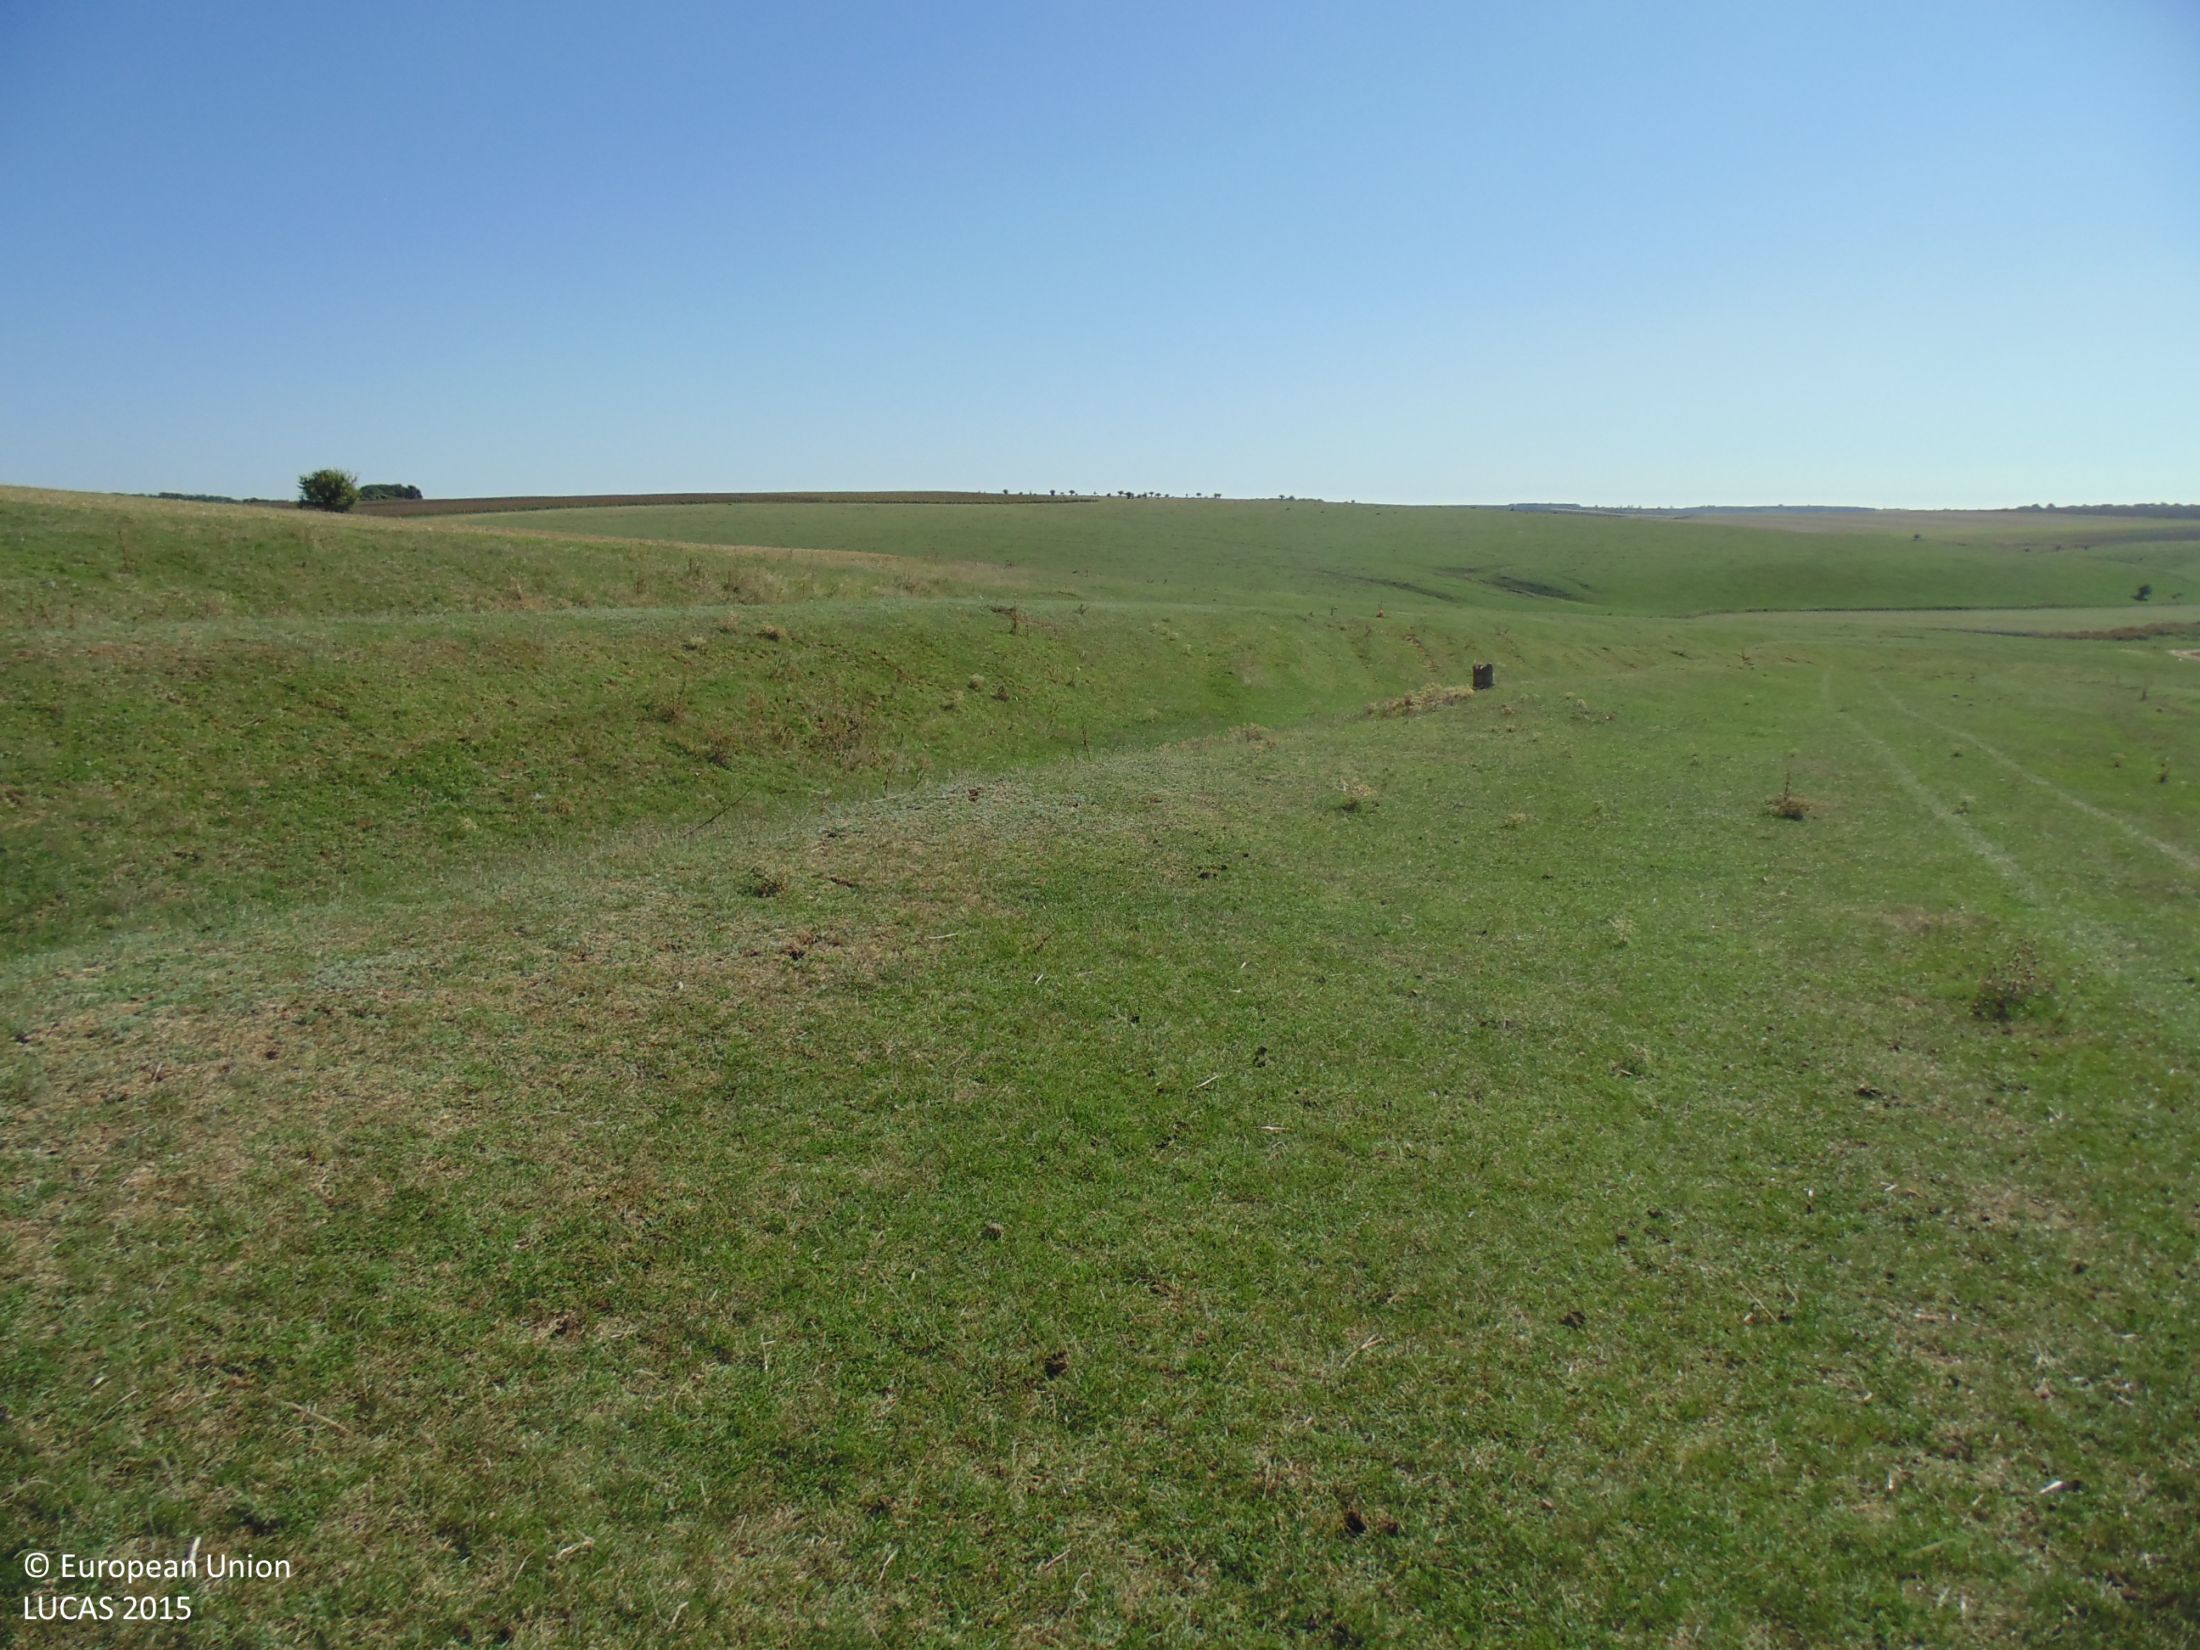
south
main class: Grassland
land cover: Grassland without tree/shrub cover
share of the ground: > 75 %
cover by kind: herbaceous plants 100 %
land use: Agriculture (excluding fallow land and kitchen gardens)
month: September
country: BG
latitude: 43.7251
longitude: 27.1176
